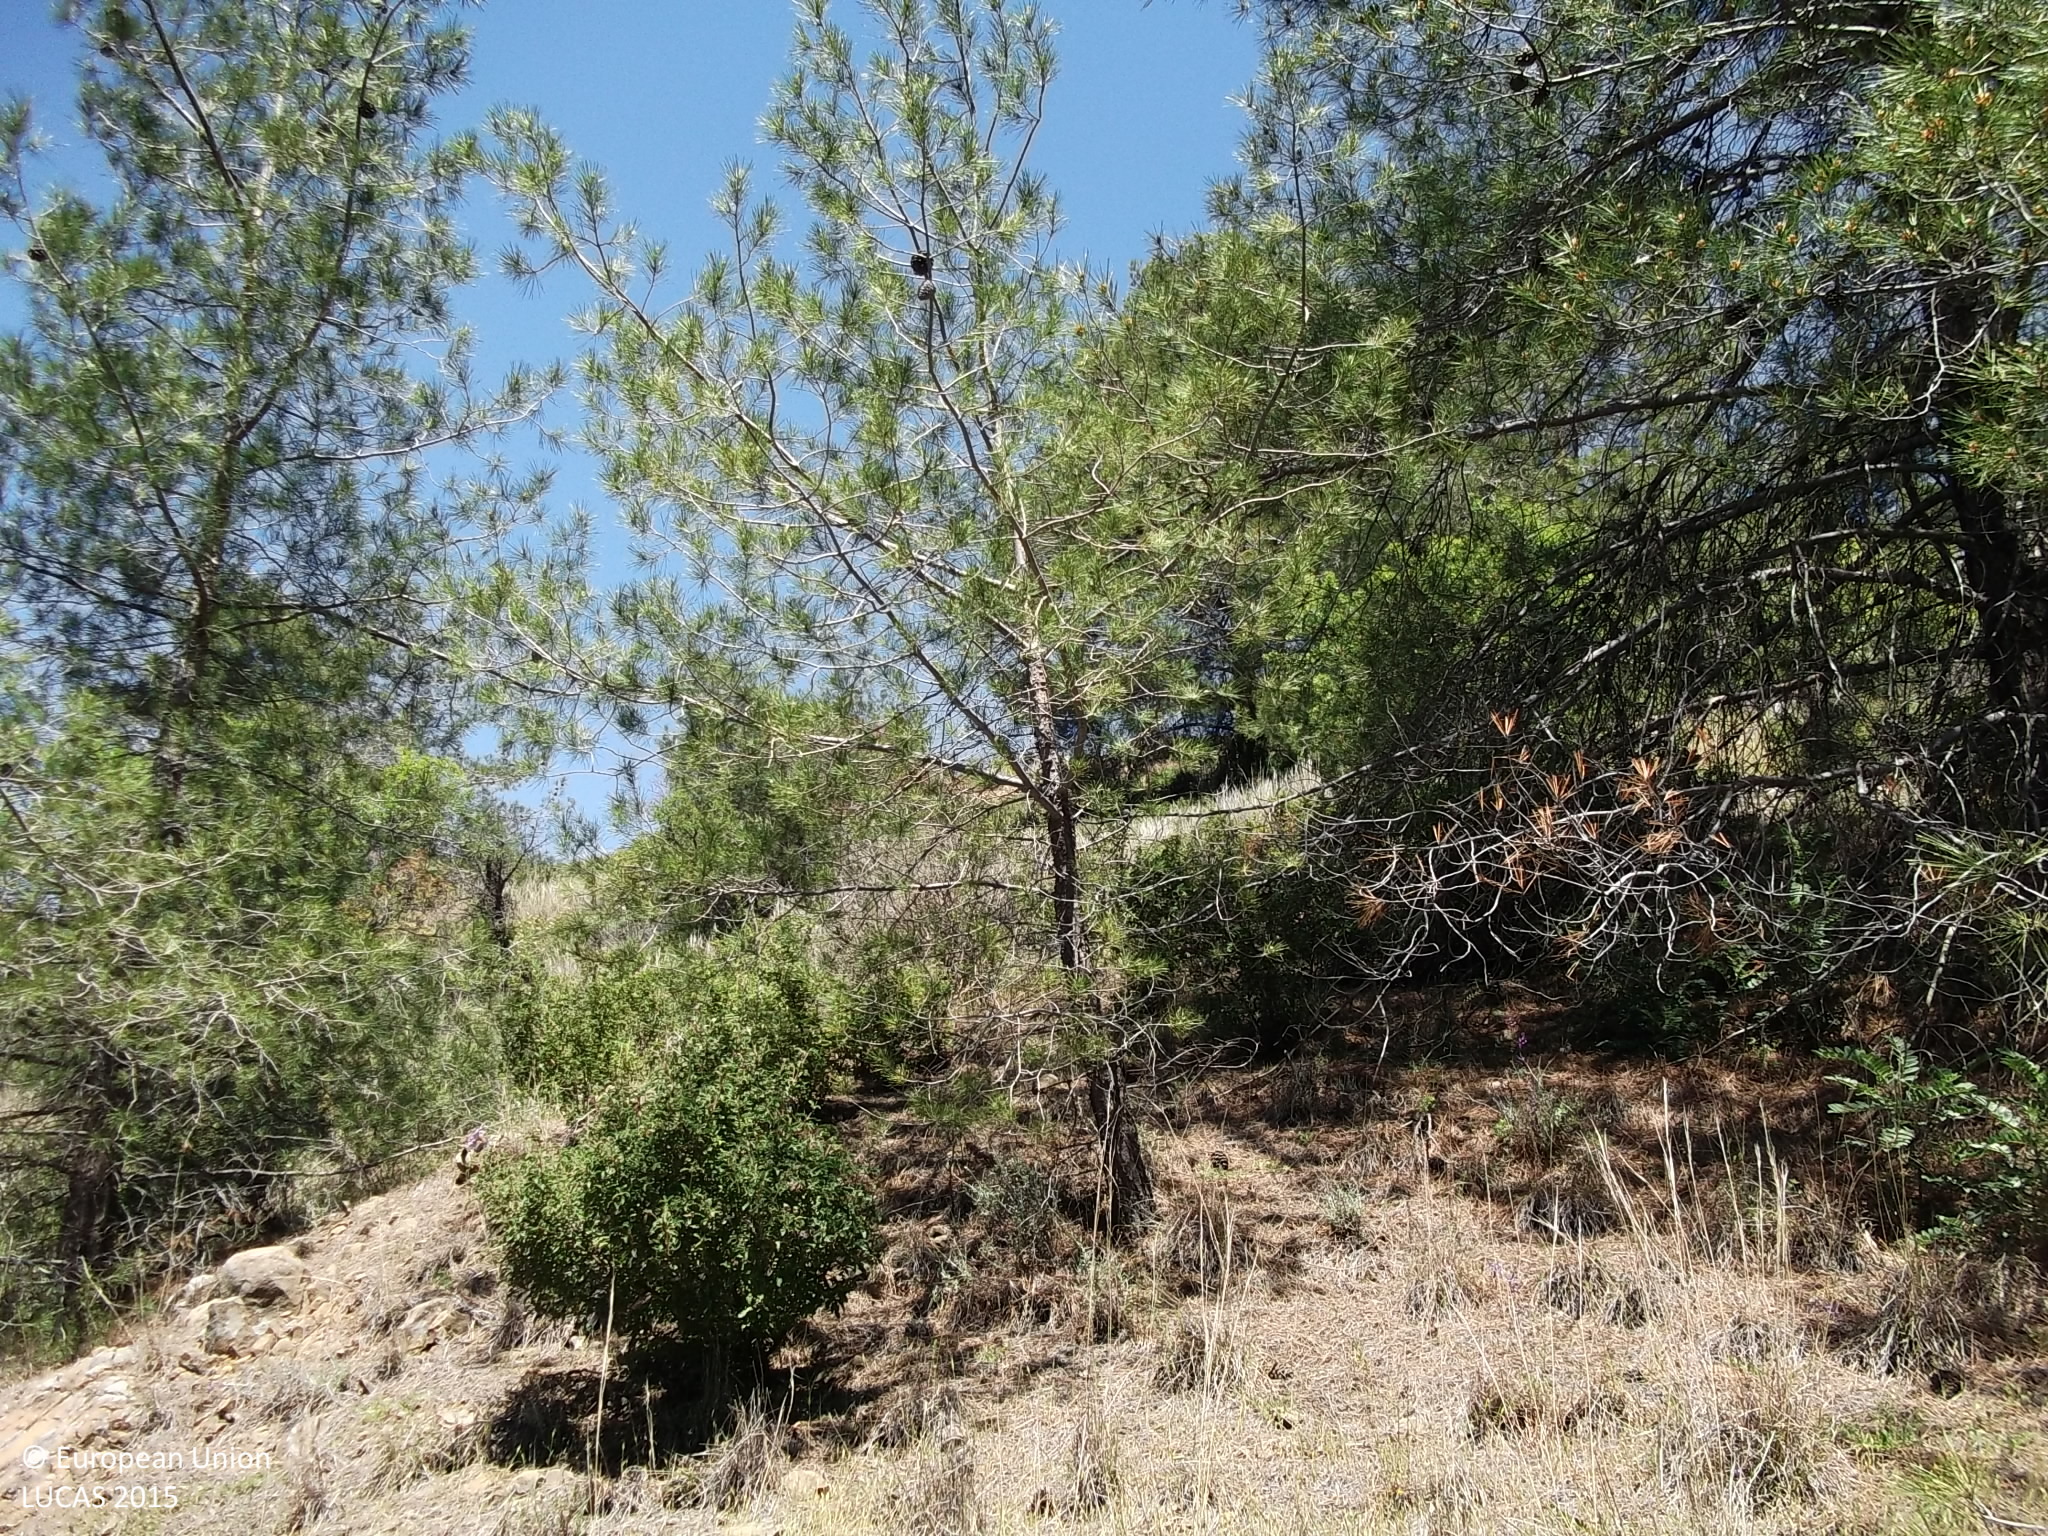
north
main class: Woodland
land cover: Pine dominated coniferous woodland
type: coniferous forest of the mediterranean region
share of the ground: 50 - 75 %
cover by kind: coniferous forest trees 70 %, shrubs 20 %, unconsolidated bare surface 10 %
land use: Semi-natural and natural areas not in use
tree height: > 5 m
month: April
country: CY
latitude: 34.9406
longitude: 33.1598
